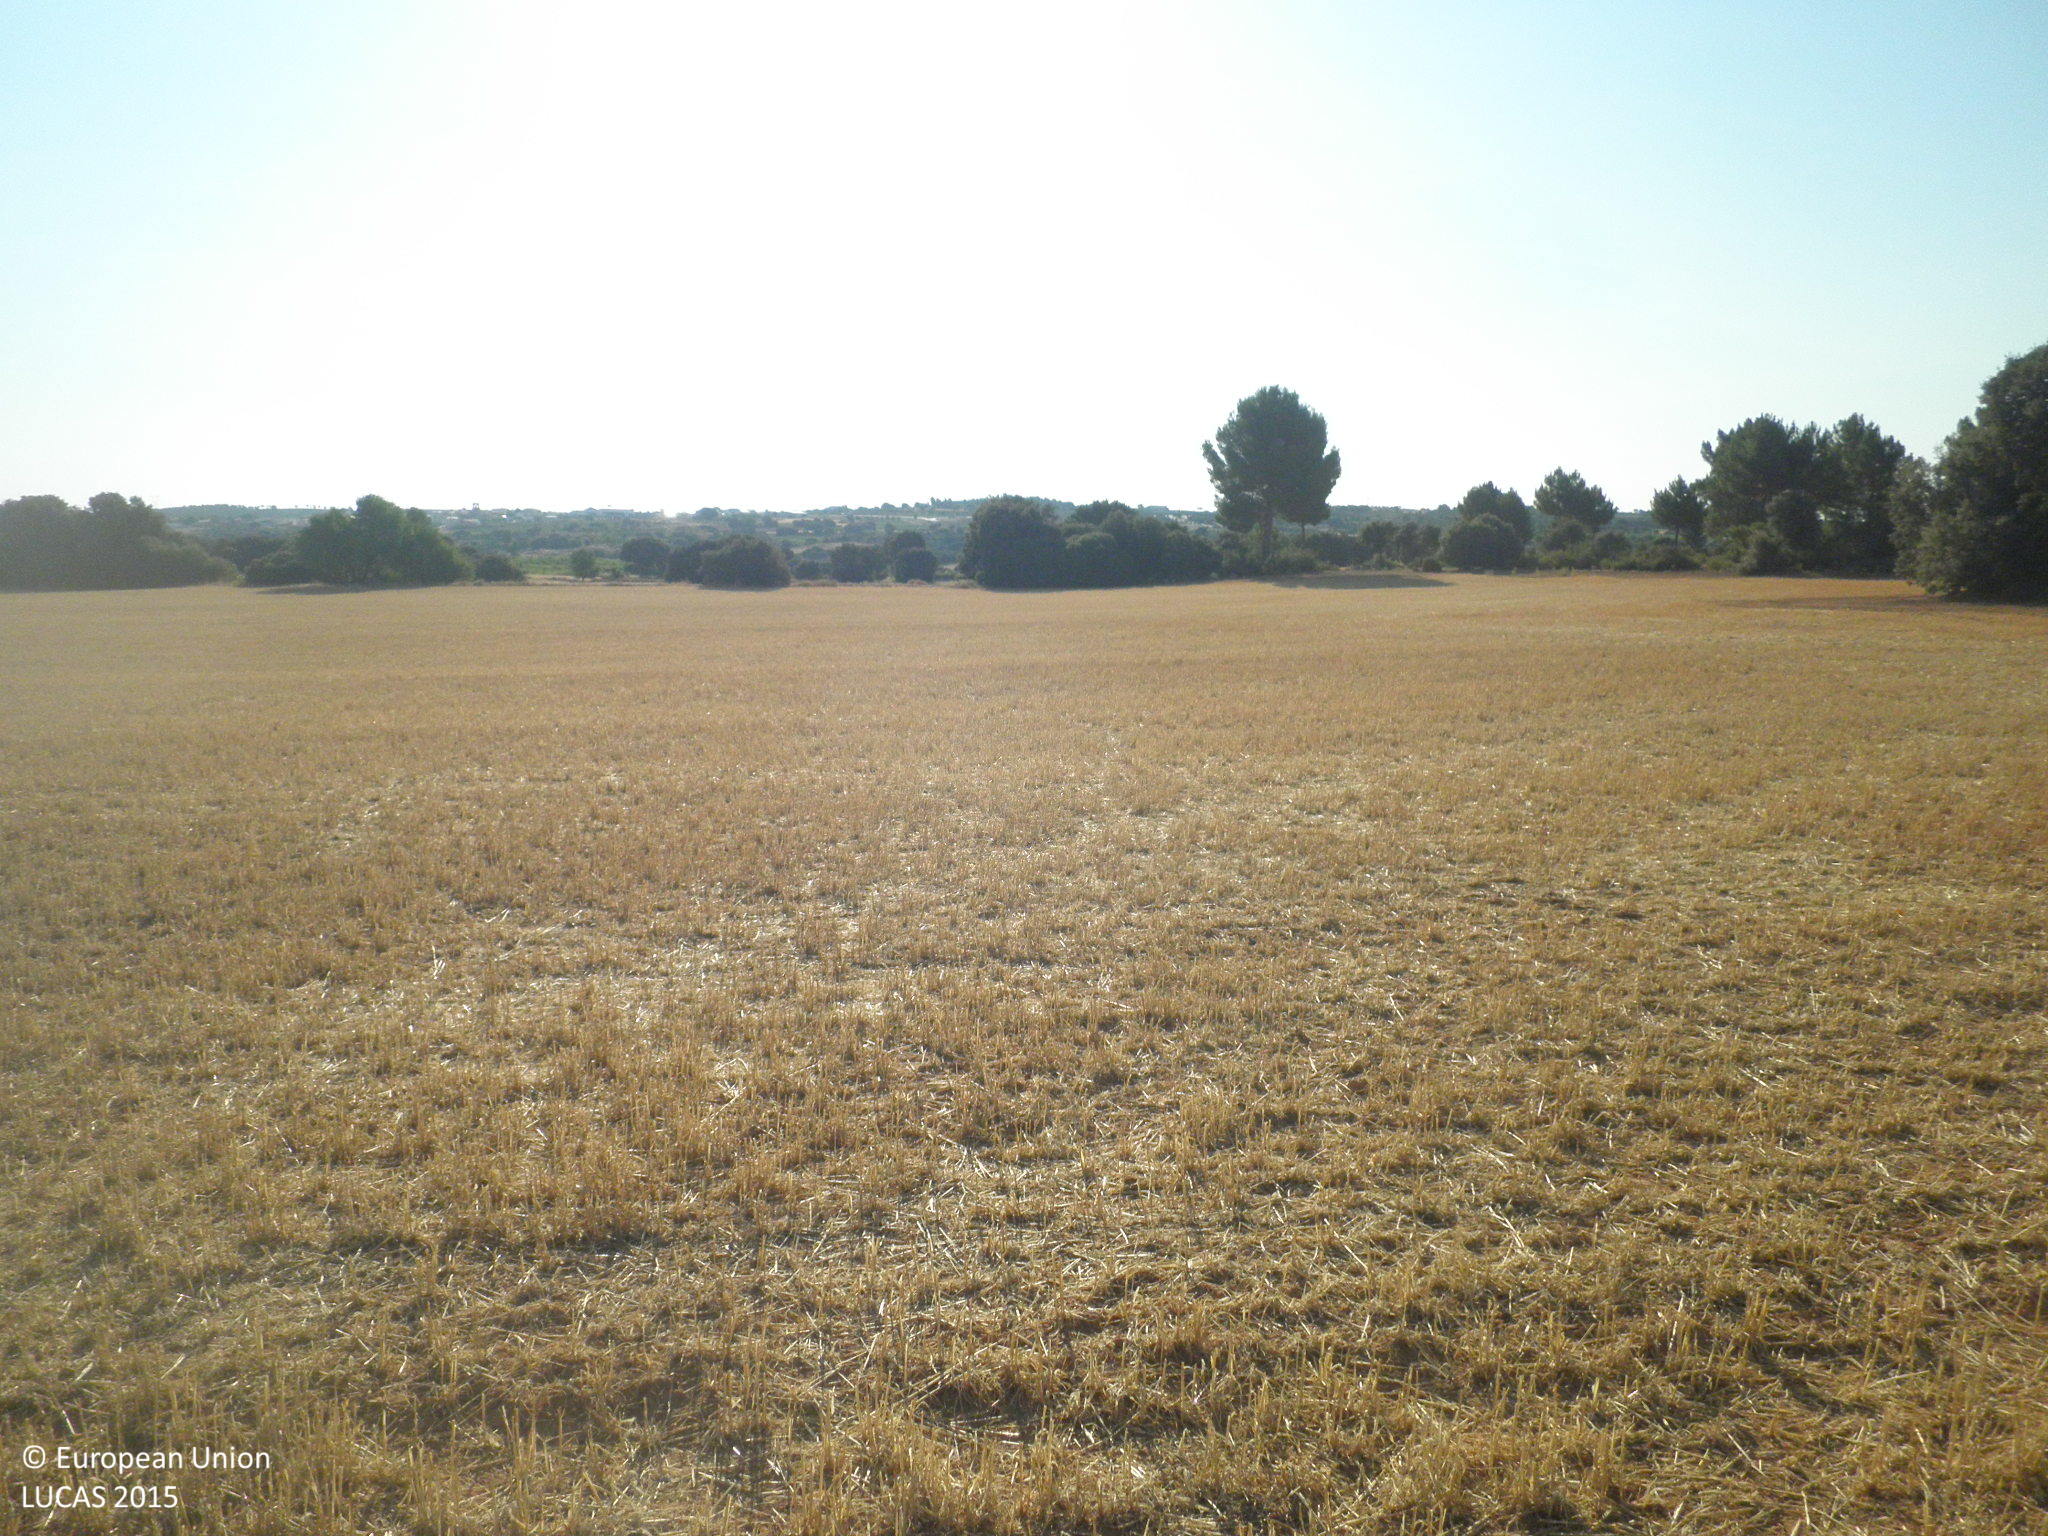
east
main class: Cropland
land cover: Barley
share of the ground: < 10 %
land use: Agriculture (excluding fallow land and kitchen gardens)
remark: Harvested field
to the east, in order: Barley; Dry stone walls; Other mixed woodland; Barley
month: July
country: ES
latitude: 39.5106
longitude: -1.6944
